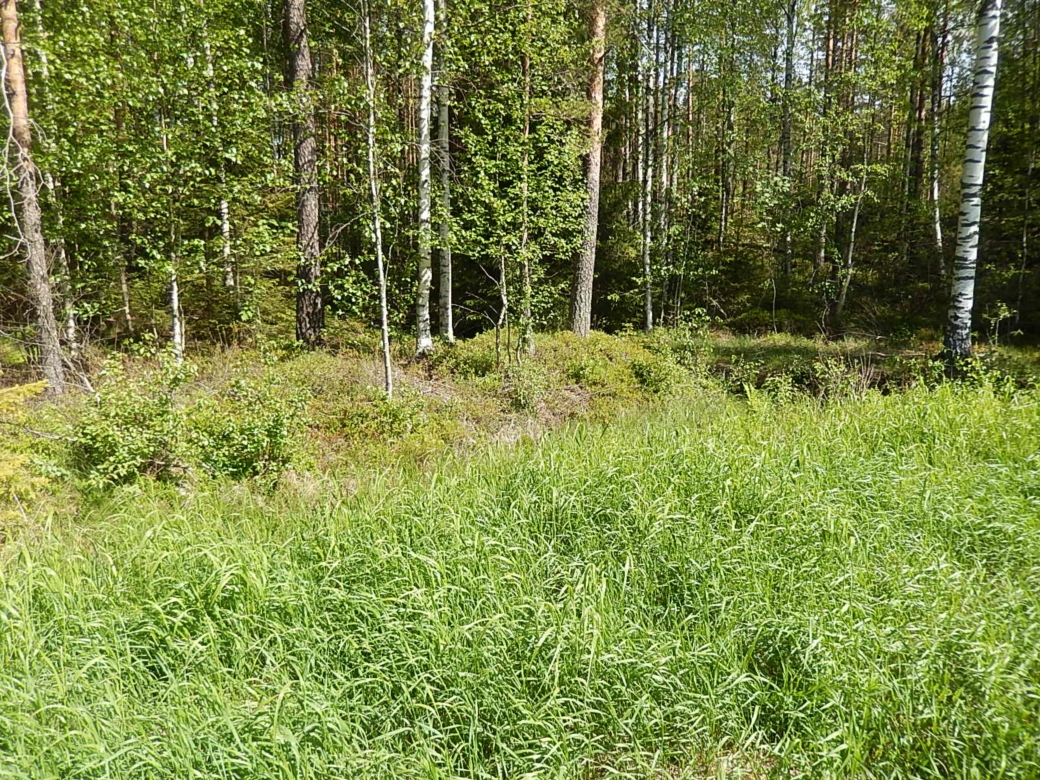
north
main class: Grassland
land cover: Grassland without tree/shrub cover
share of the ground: > 75 %
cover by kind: herbaceous plants 100 %
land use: Abandoned areas
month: June
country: FI
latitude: 61.8613
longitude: 22.1639
